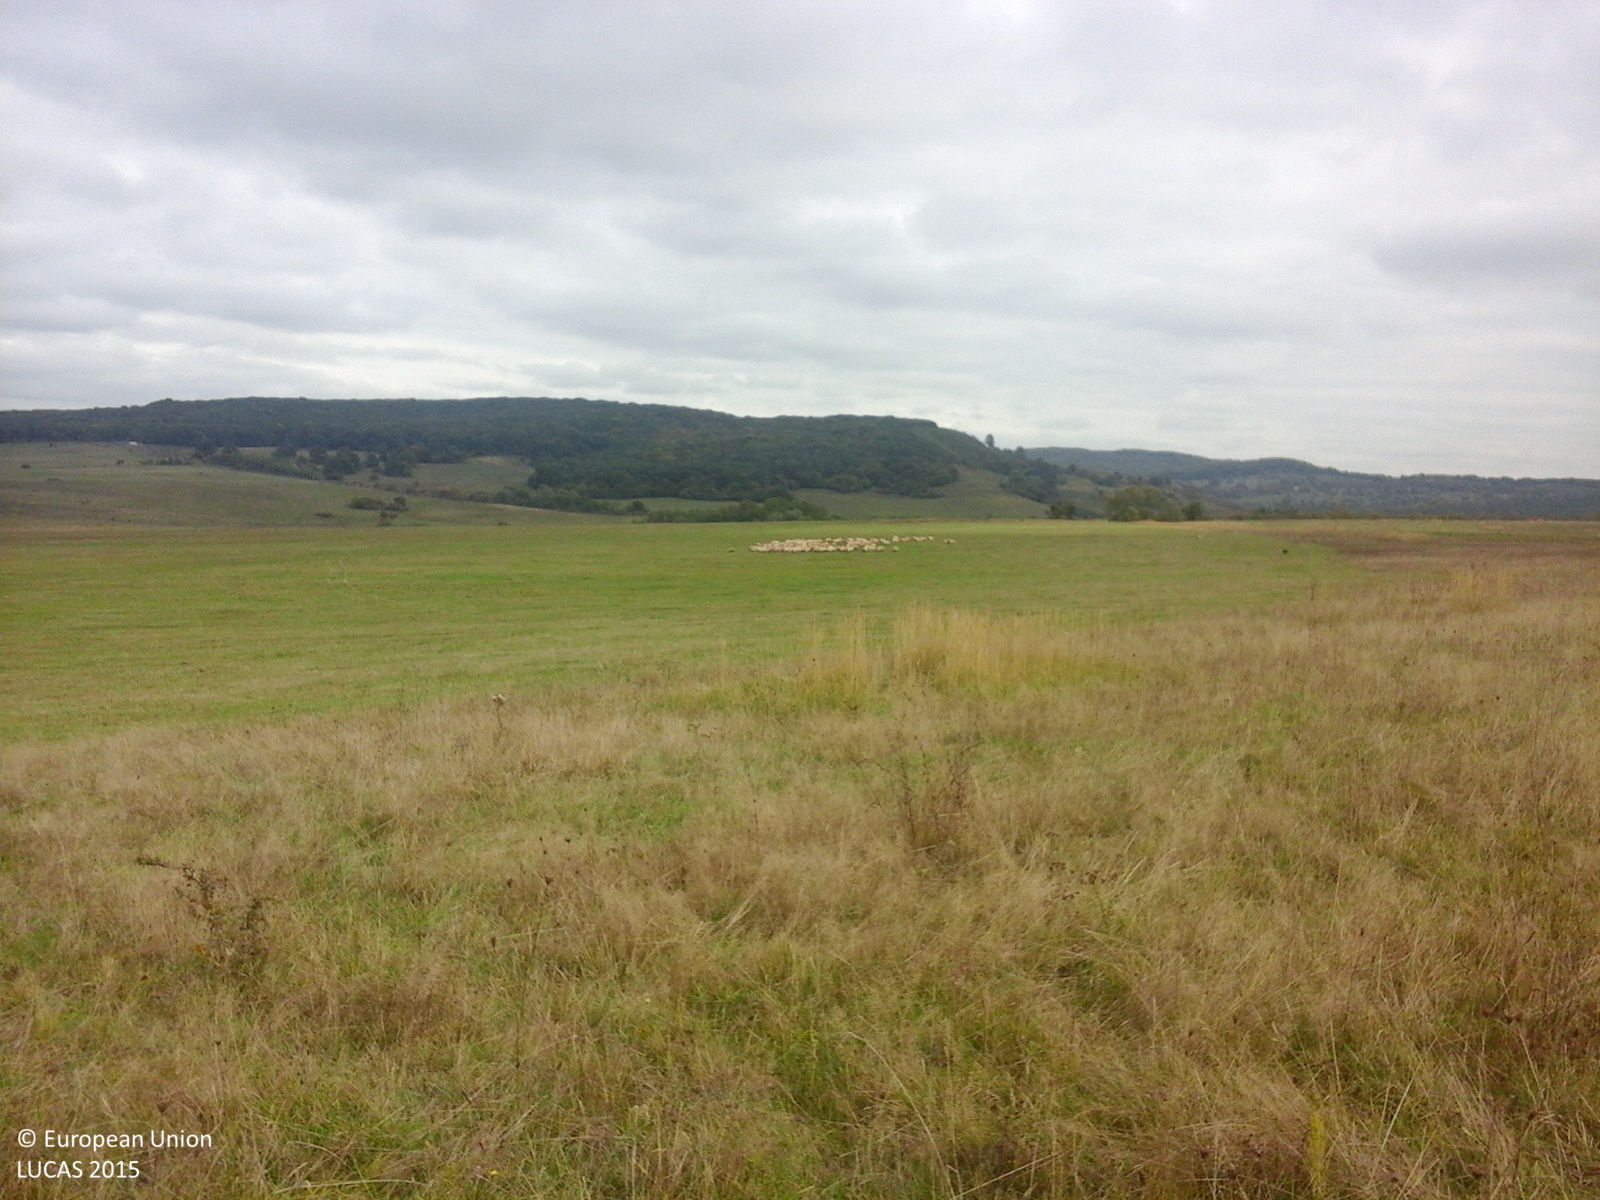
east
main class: Grassland
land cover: Grassland without tree/shrub cover
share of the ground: > 75 %
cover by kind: herbaceous plants 100 %
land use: Agriculture (excluding fallow land and kitchen gardens)
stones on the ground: < 10 %
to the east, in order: Grassland without tree/shrub cover
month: October
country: RO
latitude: 45.9397
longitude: 24.6481
